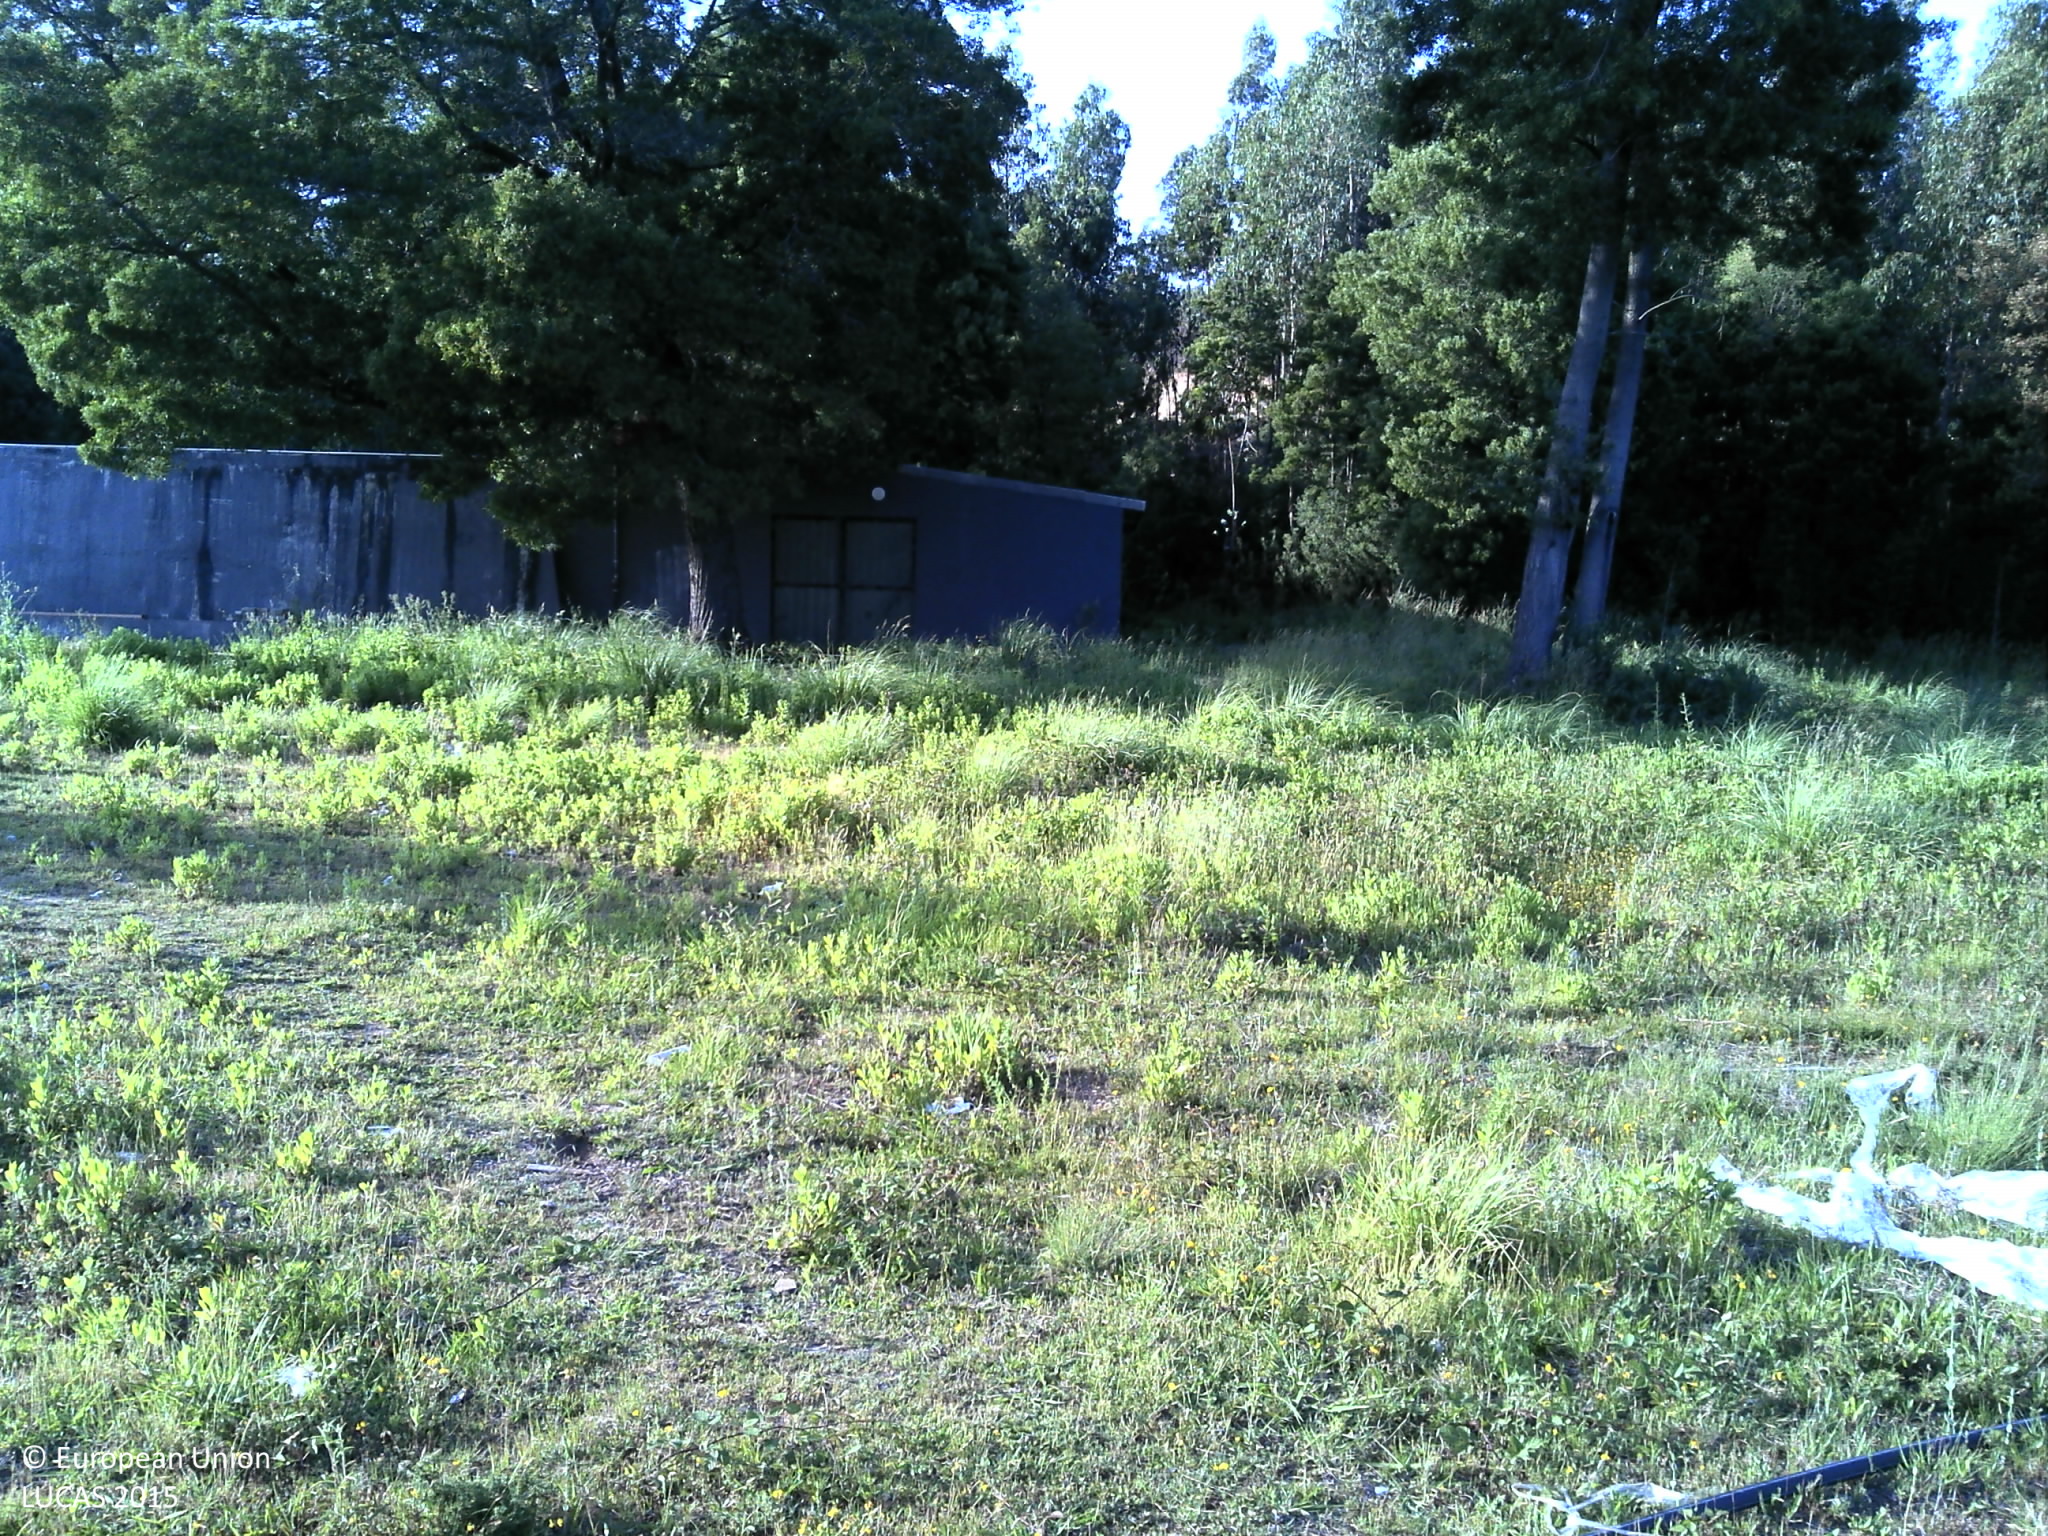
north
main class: Grassland
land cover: Spontaneously vegetated surfaces
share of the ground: 25 - 50 %
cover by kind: herbaceous plants 50 %, unconsolidated bare surface 50 %
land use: Abandoned areas
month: May
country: PT
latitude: 41.3700
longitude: -8.5297
